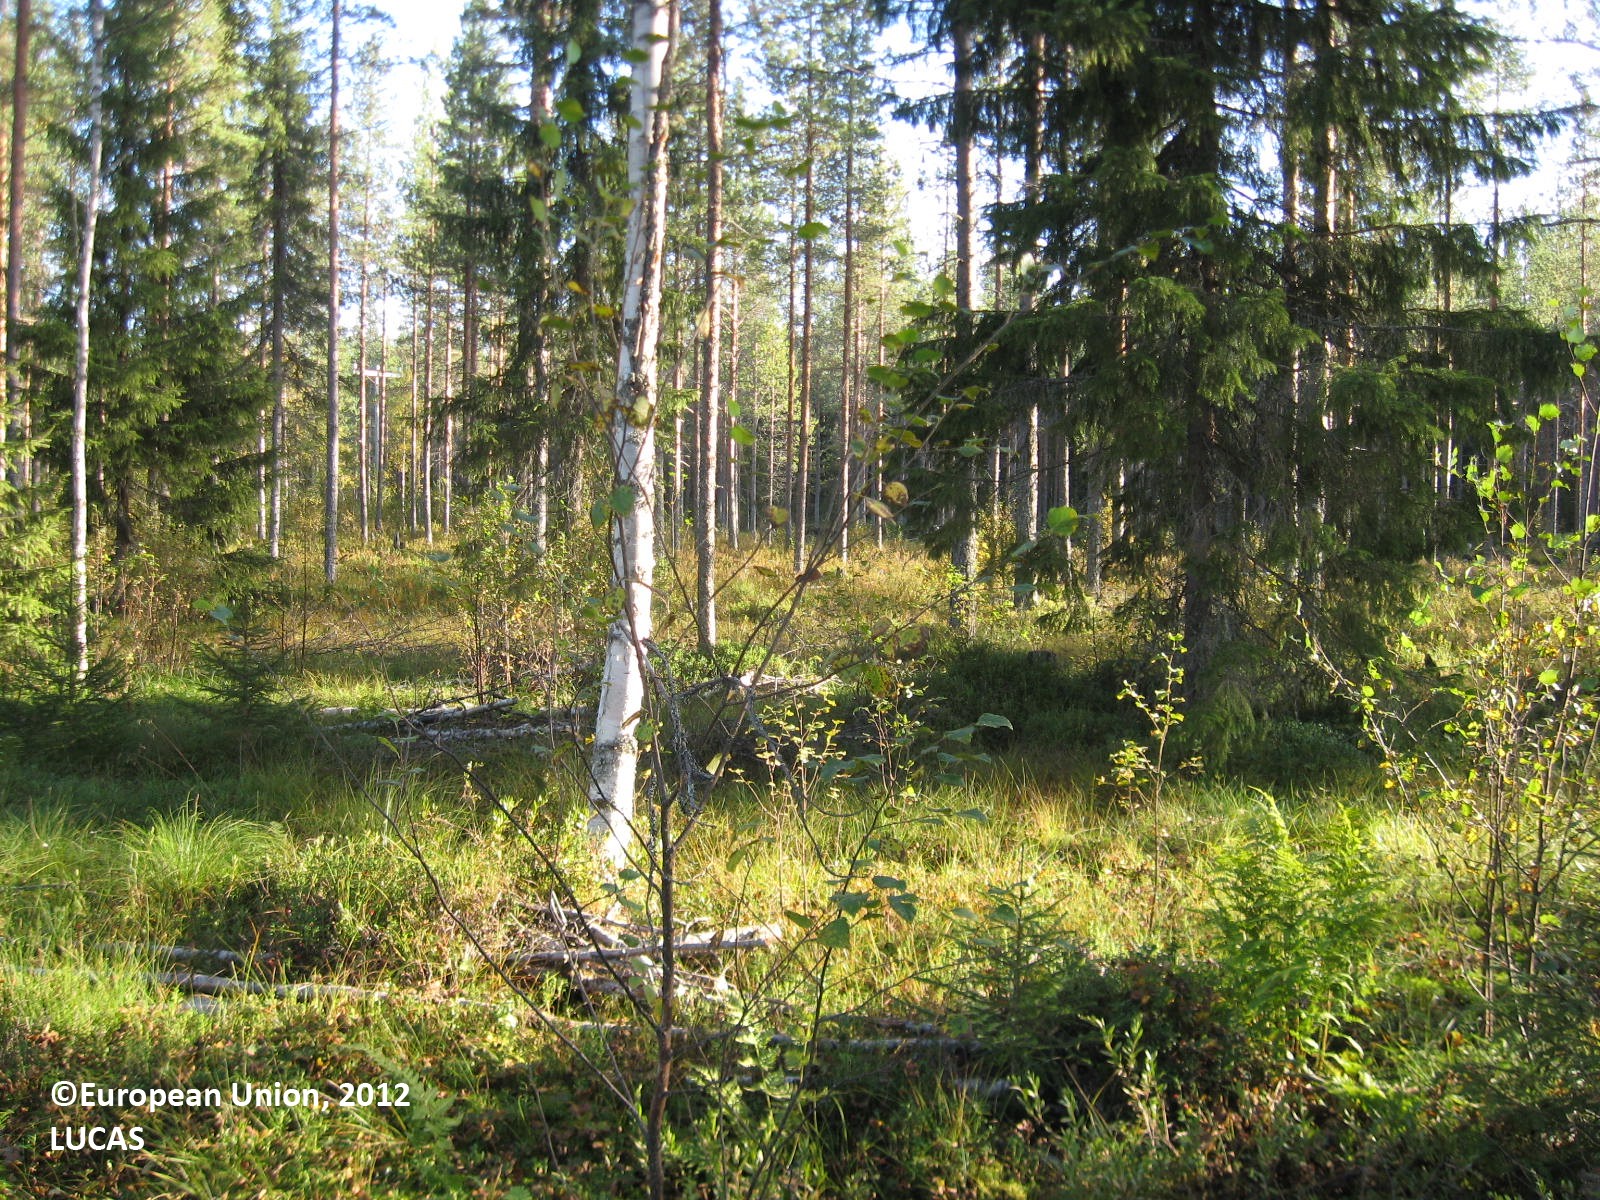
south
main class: Woodland
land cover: Other mixed woodland
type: boreal forest
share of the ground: > 75 %
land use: Forestry
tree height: > 5 m
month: August
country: FI
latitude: 63.9728
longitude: 29.6521
